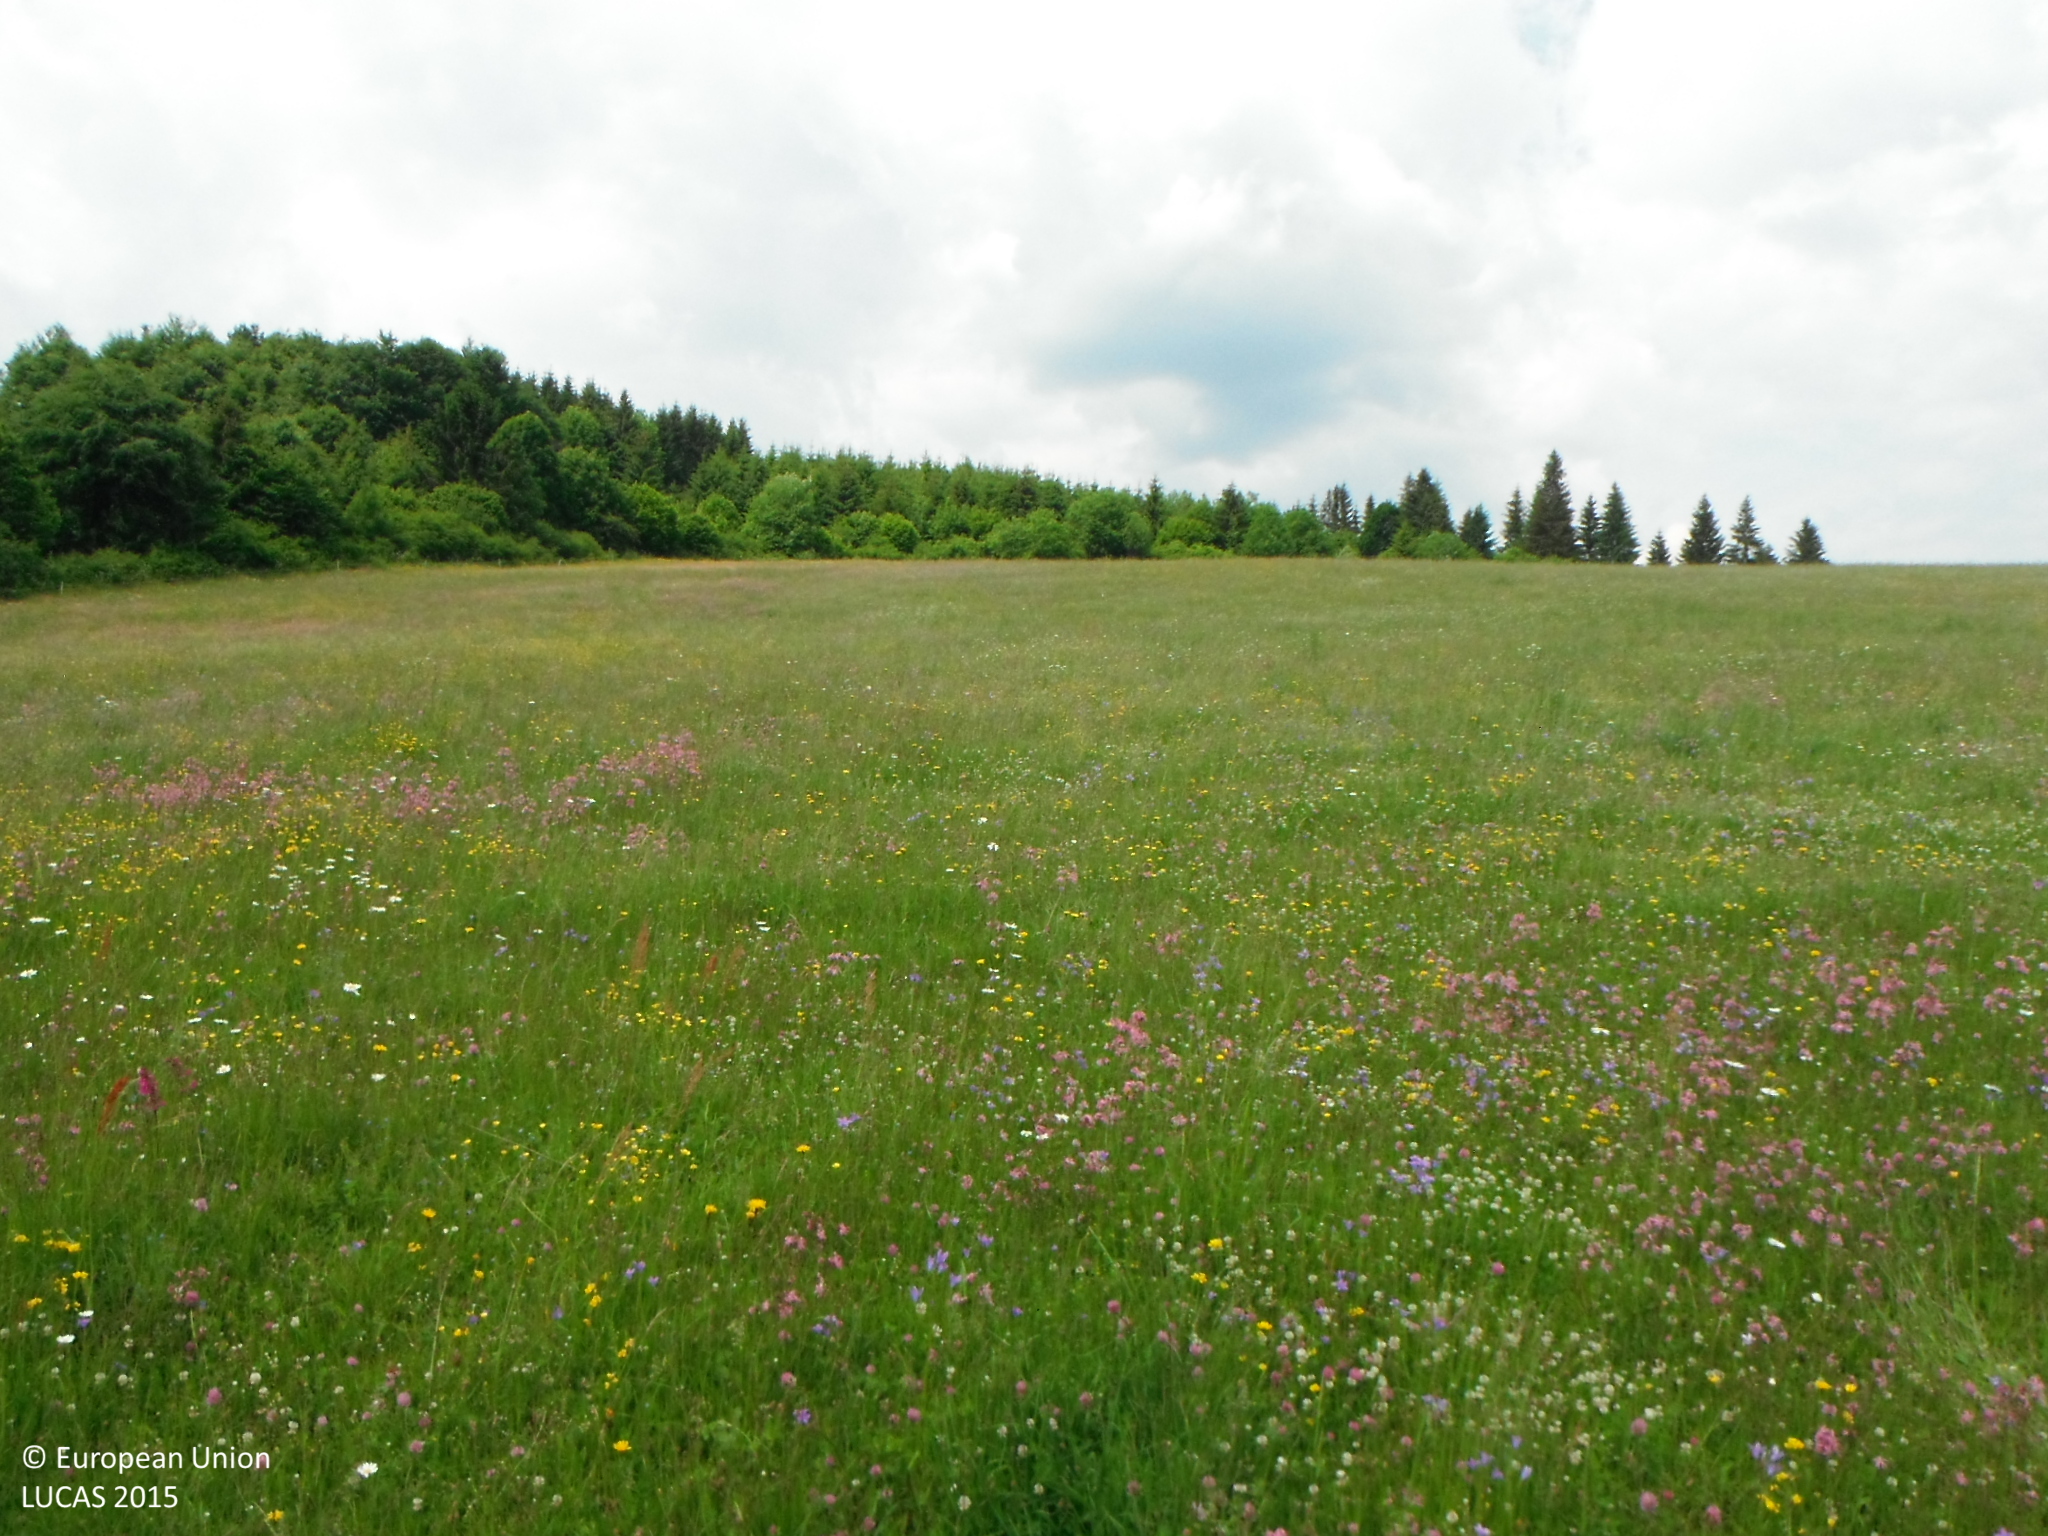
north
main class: Grassland
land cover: Grassland without tree/shrub cover
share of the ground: > 75 %
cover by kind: herbaceous plants 100 %
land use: Agriculture (excluding fallow land and kitchen gardens)
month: June
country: SK
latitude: 48.8266
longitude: 19.7125
